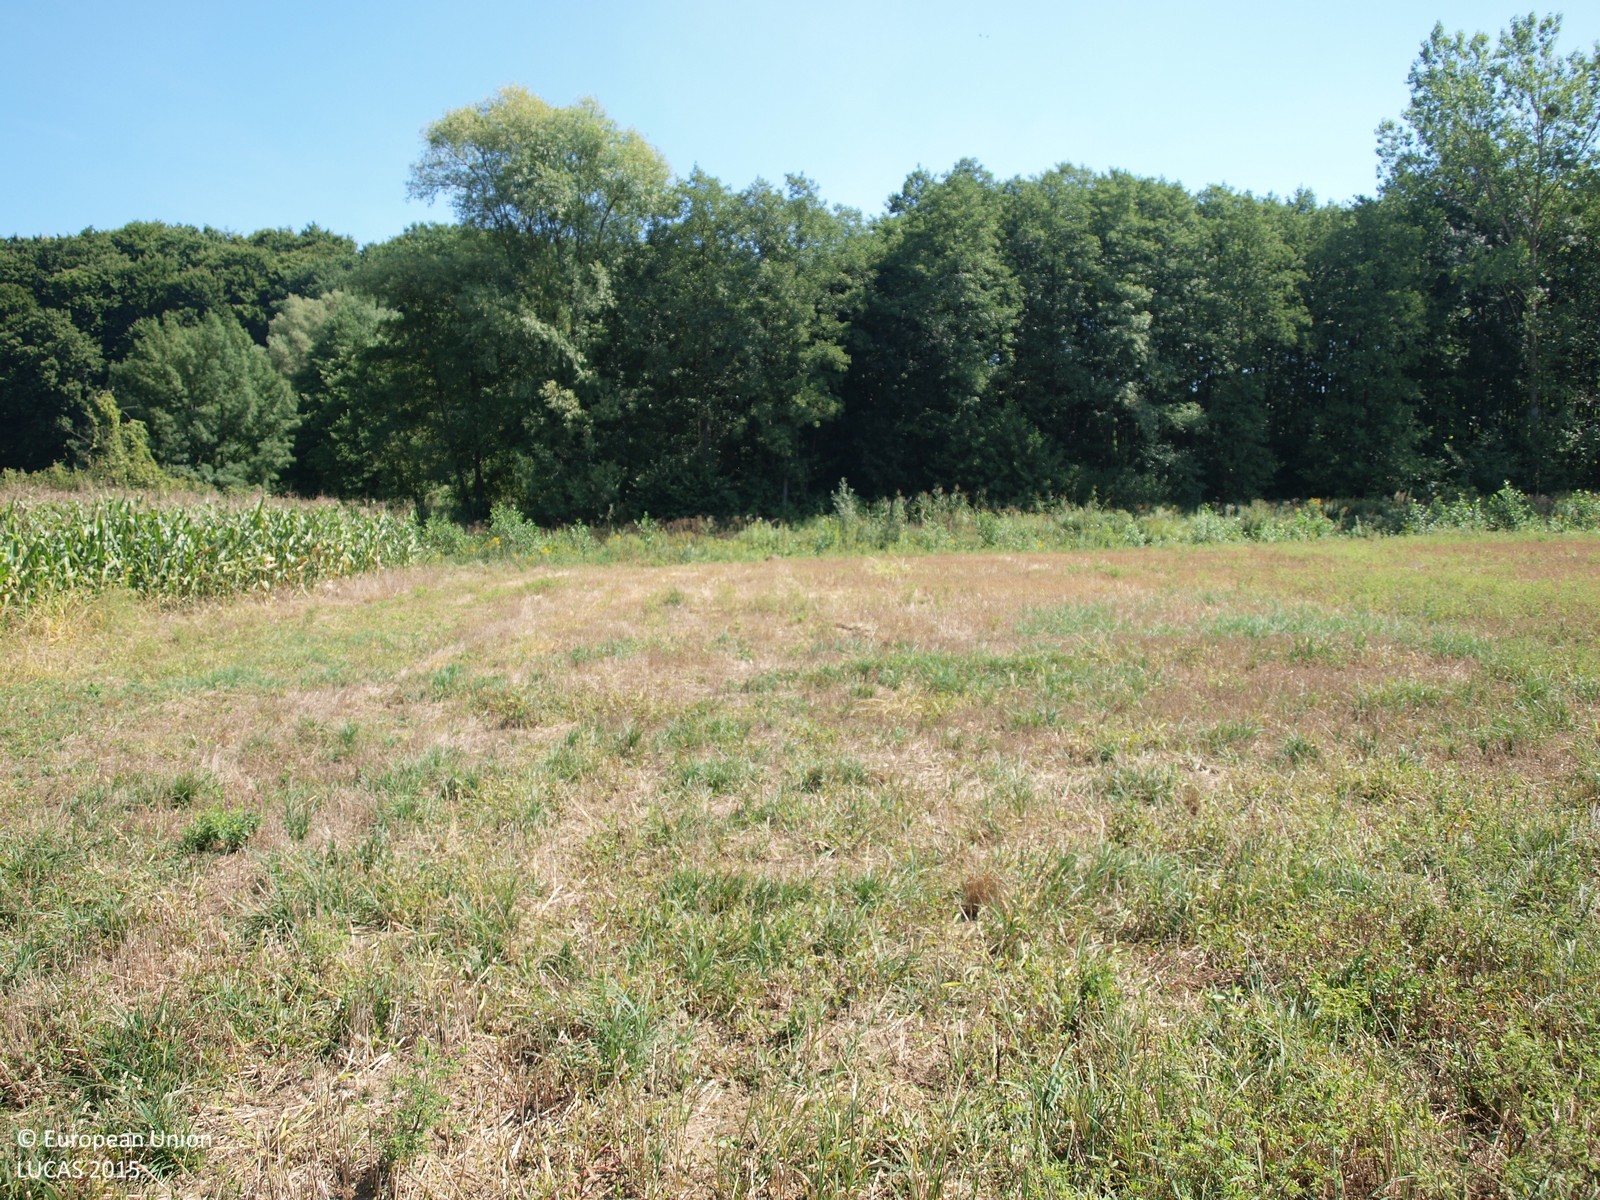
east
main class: Cropland
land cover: Barley
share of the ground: > 75 %
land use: Agriculture (excluding fallow land and kitchen gardens)
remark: Harvested field
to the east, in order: Barley; Grass margins; Ditches and canals; Broadleaved woodland
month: August
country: HR
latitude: 46.0518
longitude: 16.6824
